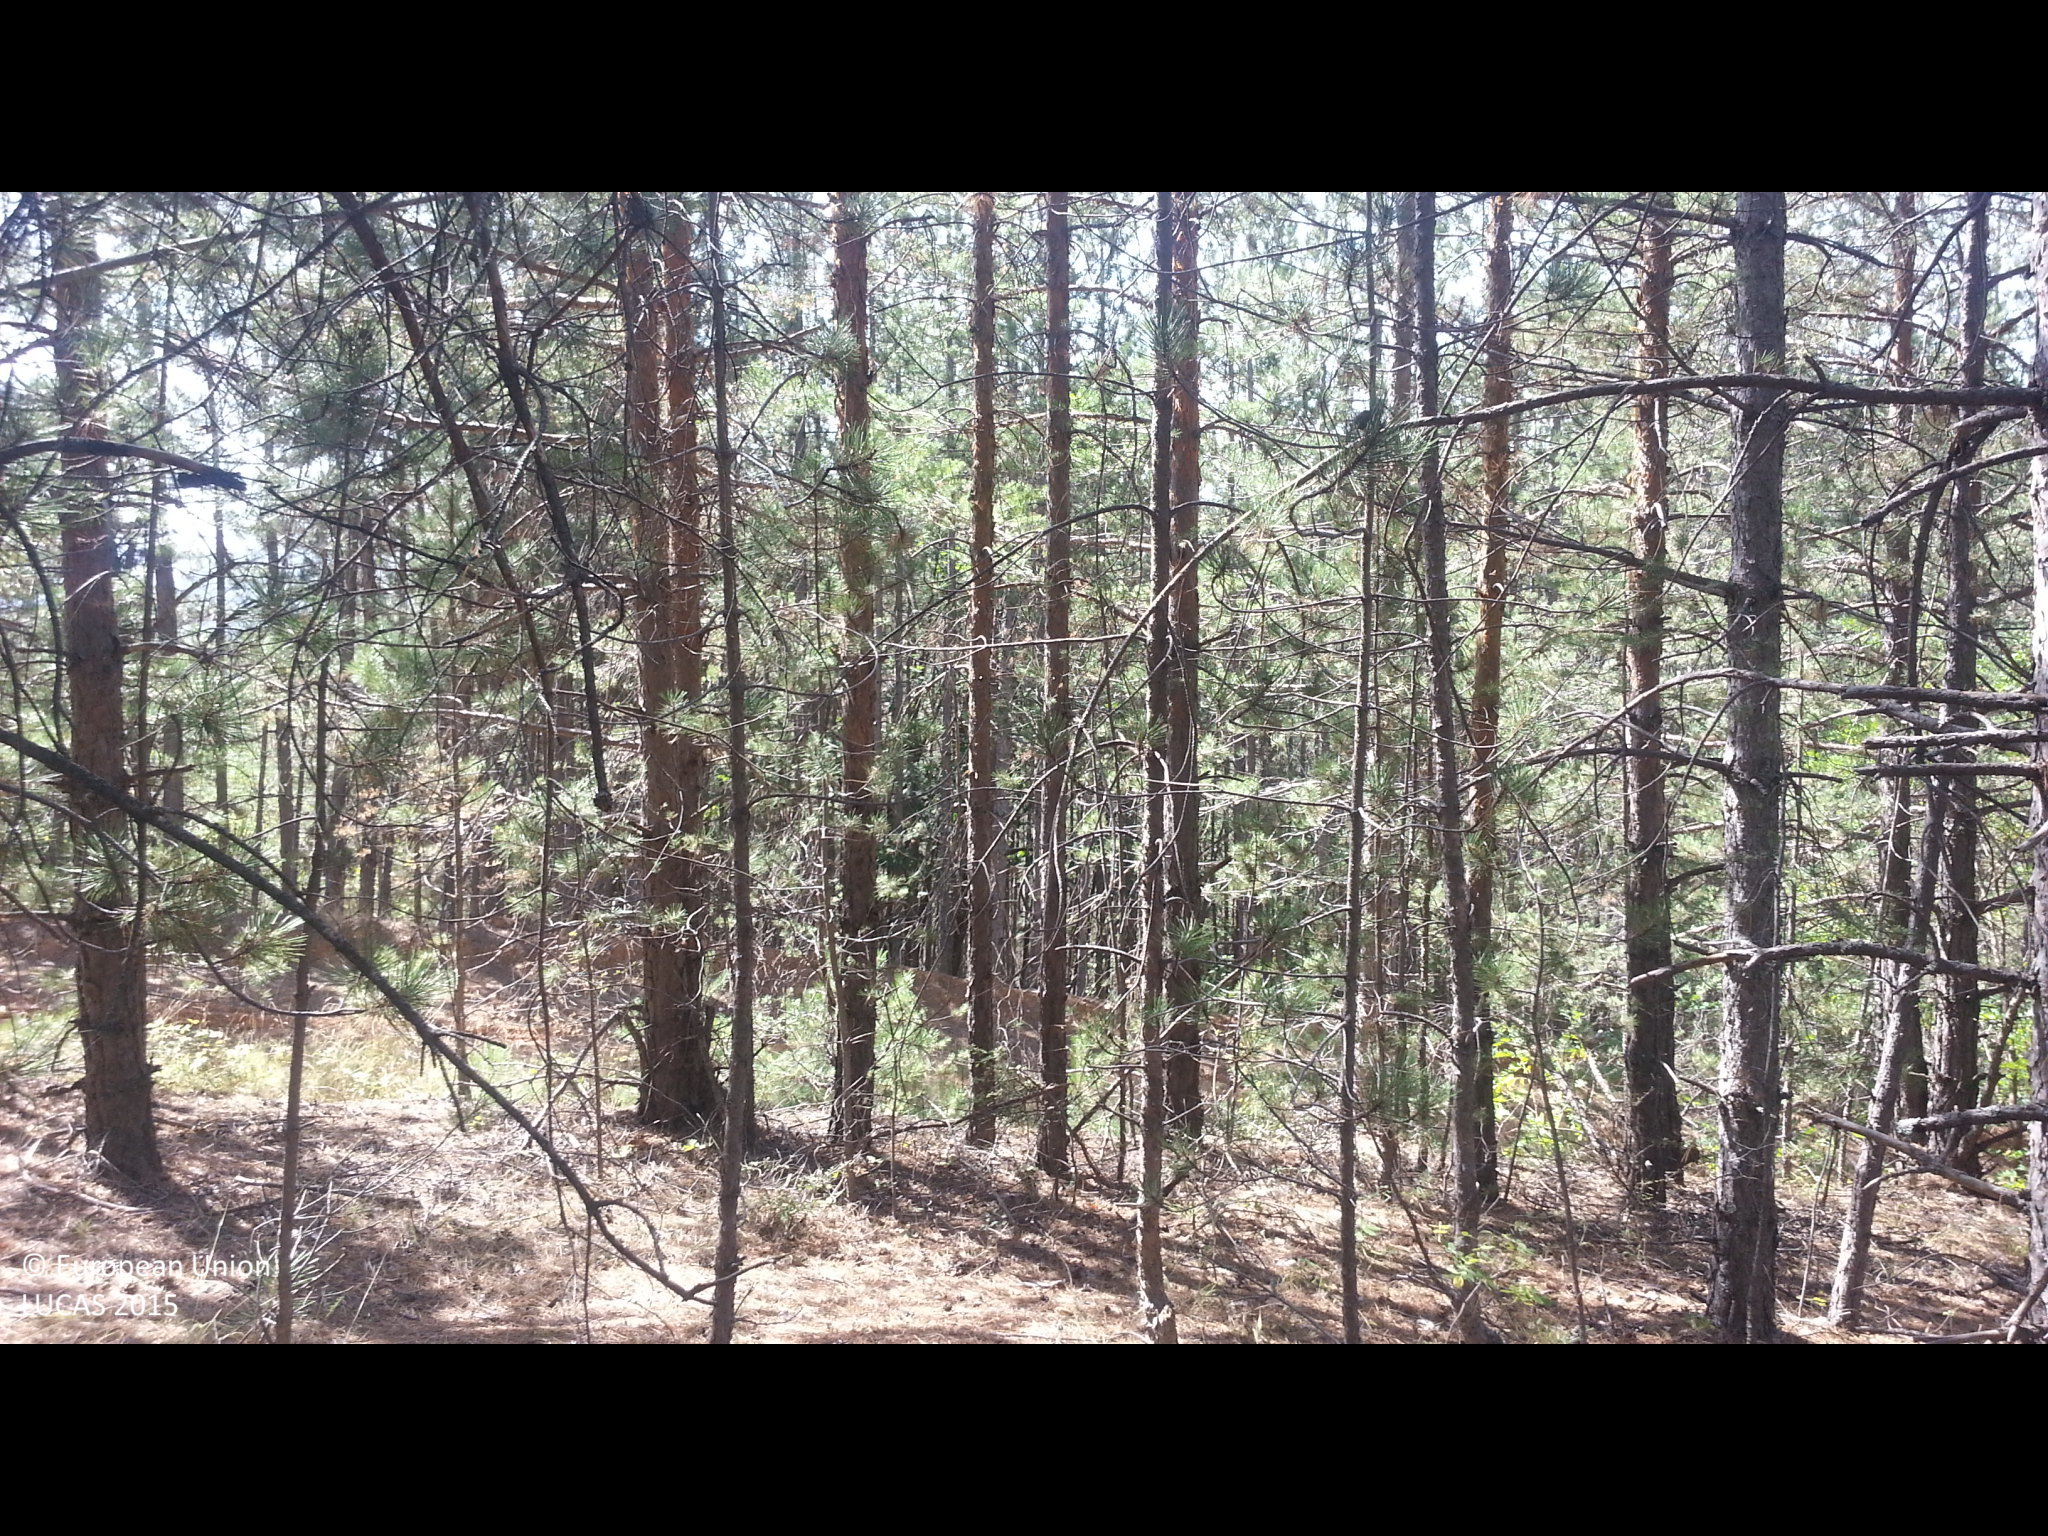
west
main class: Woodland
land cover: Pine dominated coniferous woodland
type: hemiboreal forest and nemoral coniferous forest and mixed broadleaved-coniferous forest
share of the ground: > 75 %
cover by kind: coniferous forest trees 85 %, shrubs 10 %, unconsolidated bare surface 5 %
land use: Forestry
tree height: > 5 m
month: September
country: BG
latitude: 42.1410
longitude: 22.8601
